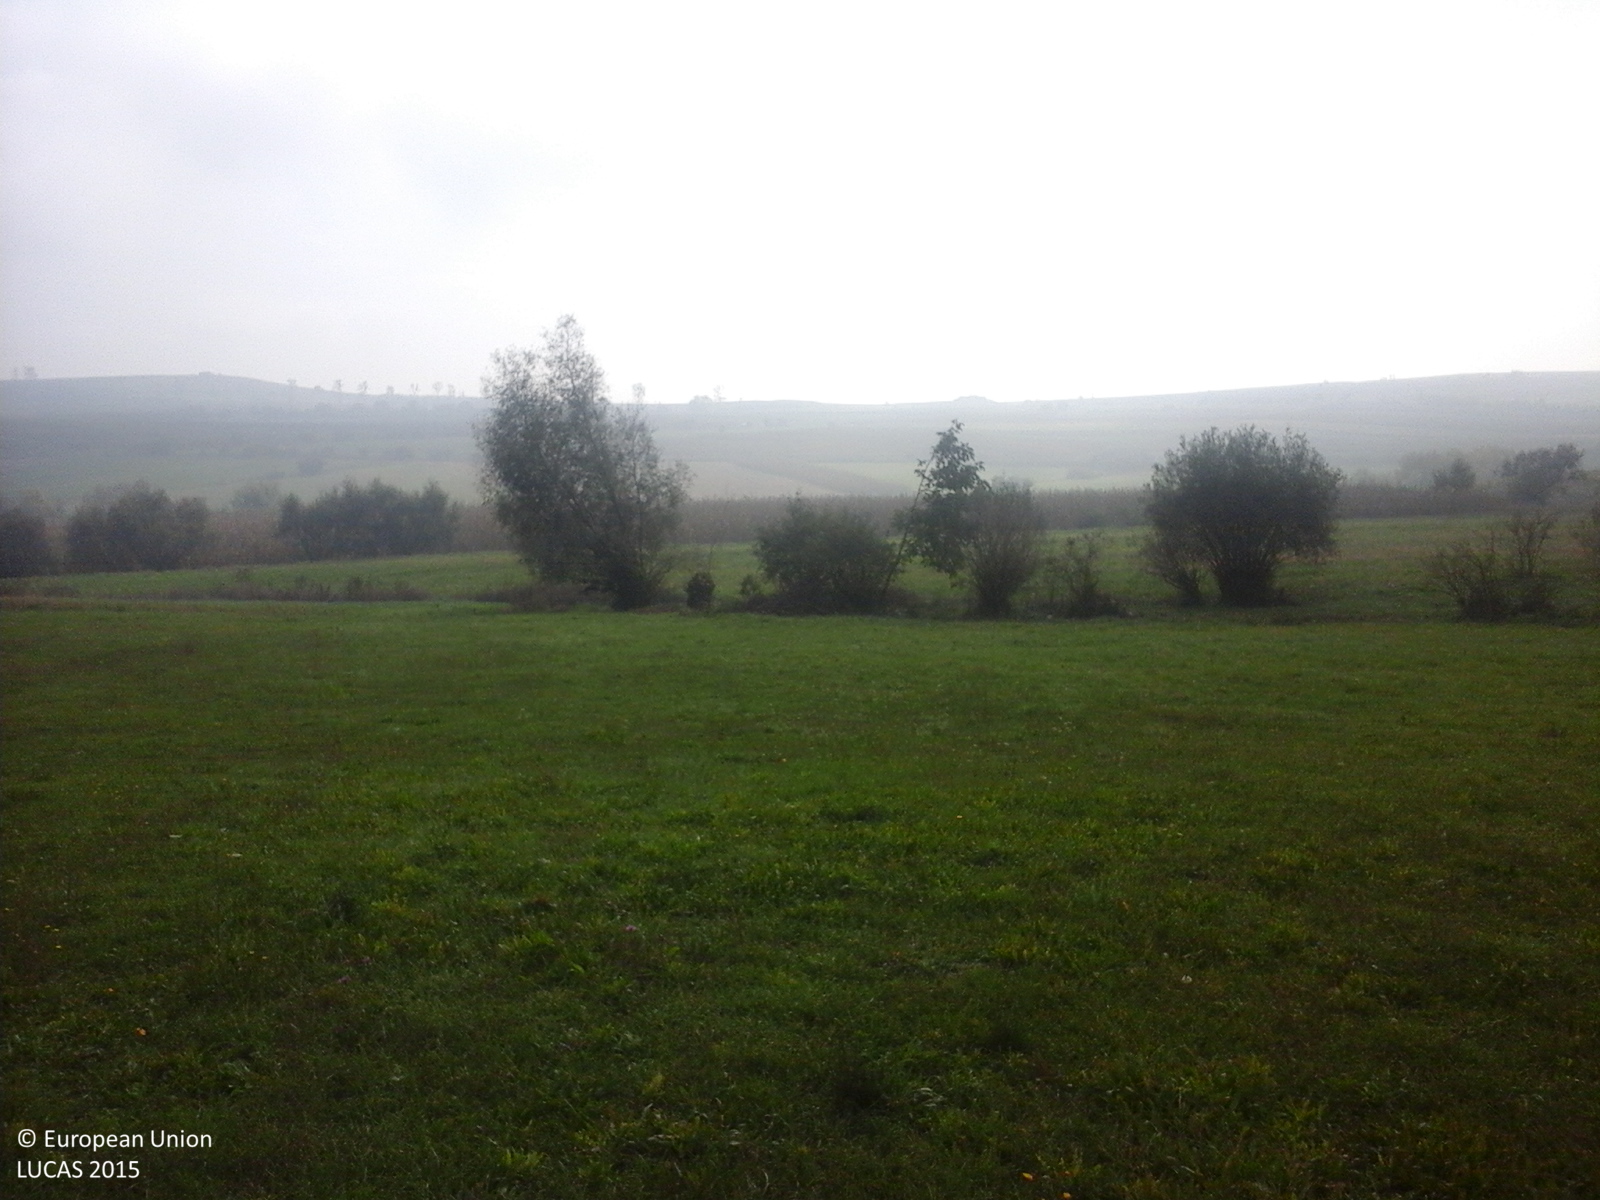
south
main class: Grassland
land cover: Grassland without tree/shrub cover
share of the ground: > 75 %
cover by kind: herbaceous plants 100 %
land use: Agriculture (excluding fallow land and kitchen gardens)
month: October
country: RO
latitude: 46.5420
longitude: 24.3900
